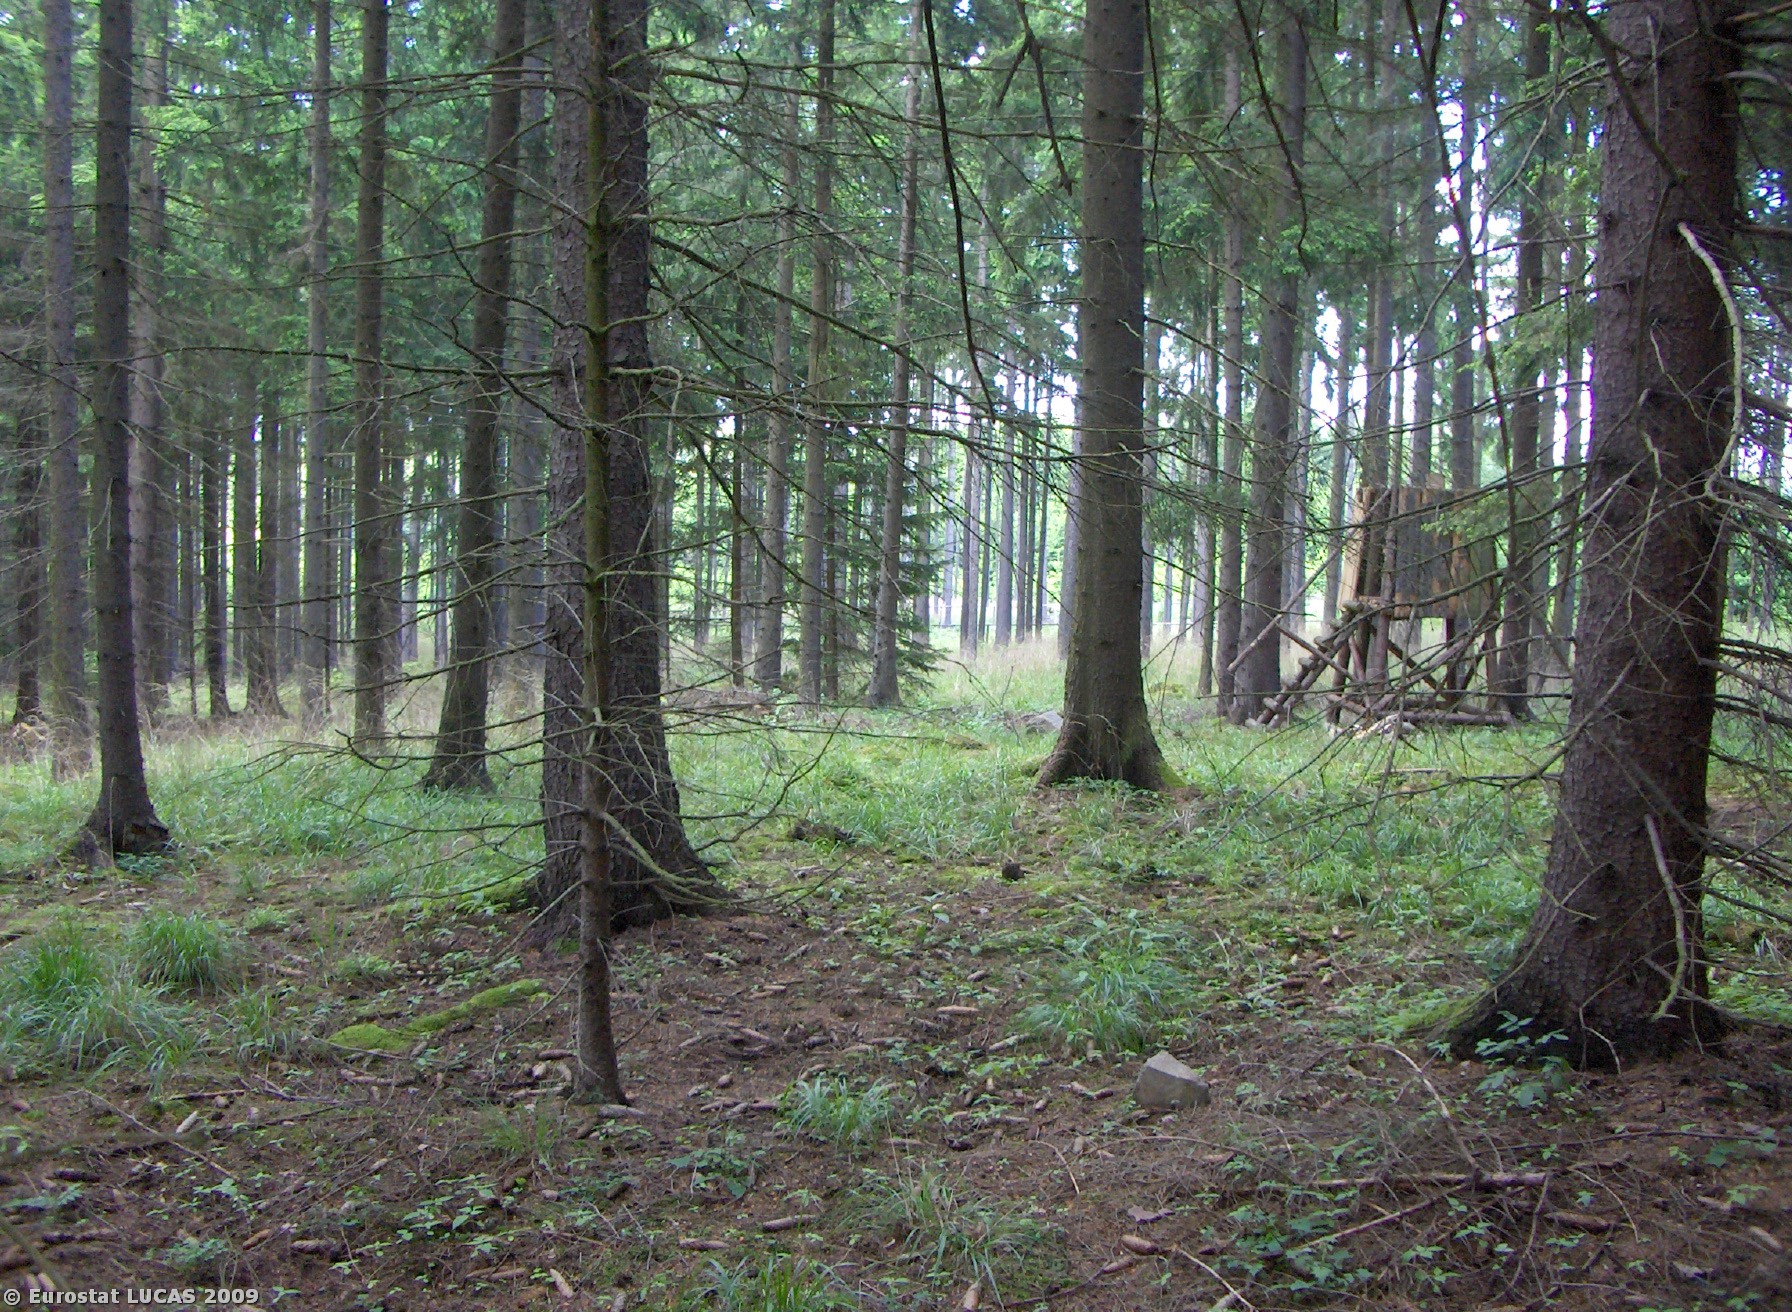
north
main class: Woodland
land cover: Coniferous woodland
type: hemiboreal forest and nemoral coniferous forest and mixed broadleaved-coniferous forest
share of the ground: > 75 %
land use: Forestry
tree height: > 5 m
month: May
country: CZ
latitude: 49.4762
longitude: 14.2104
